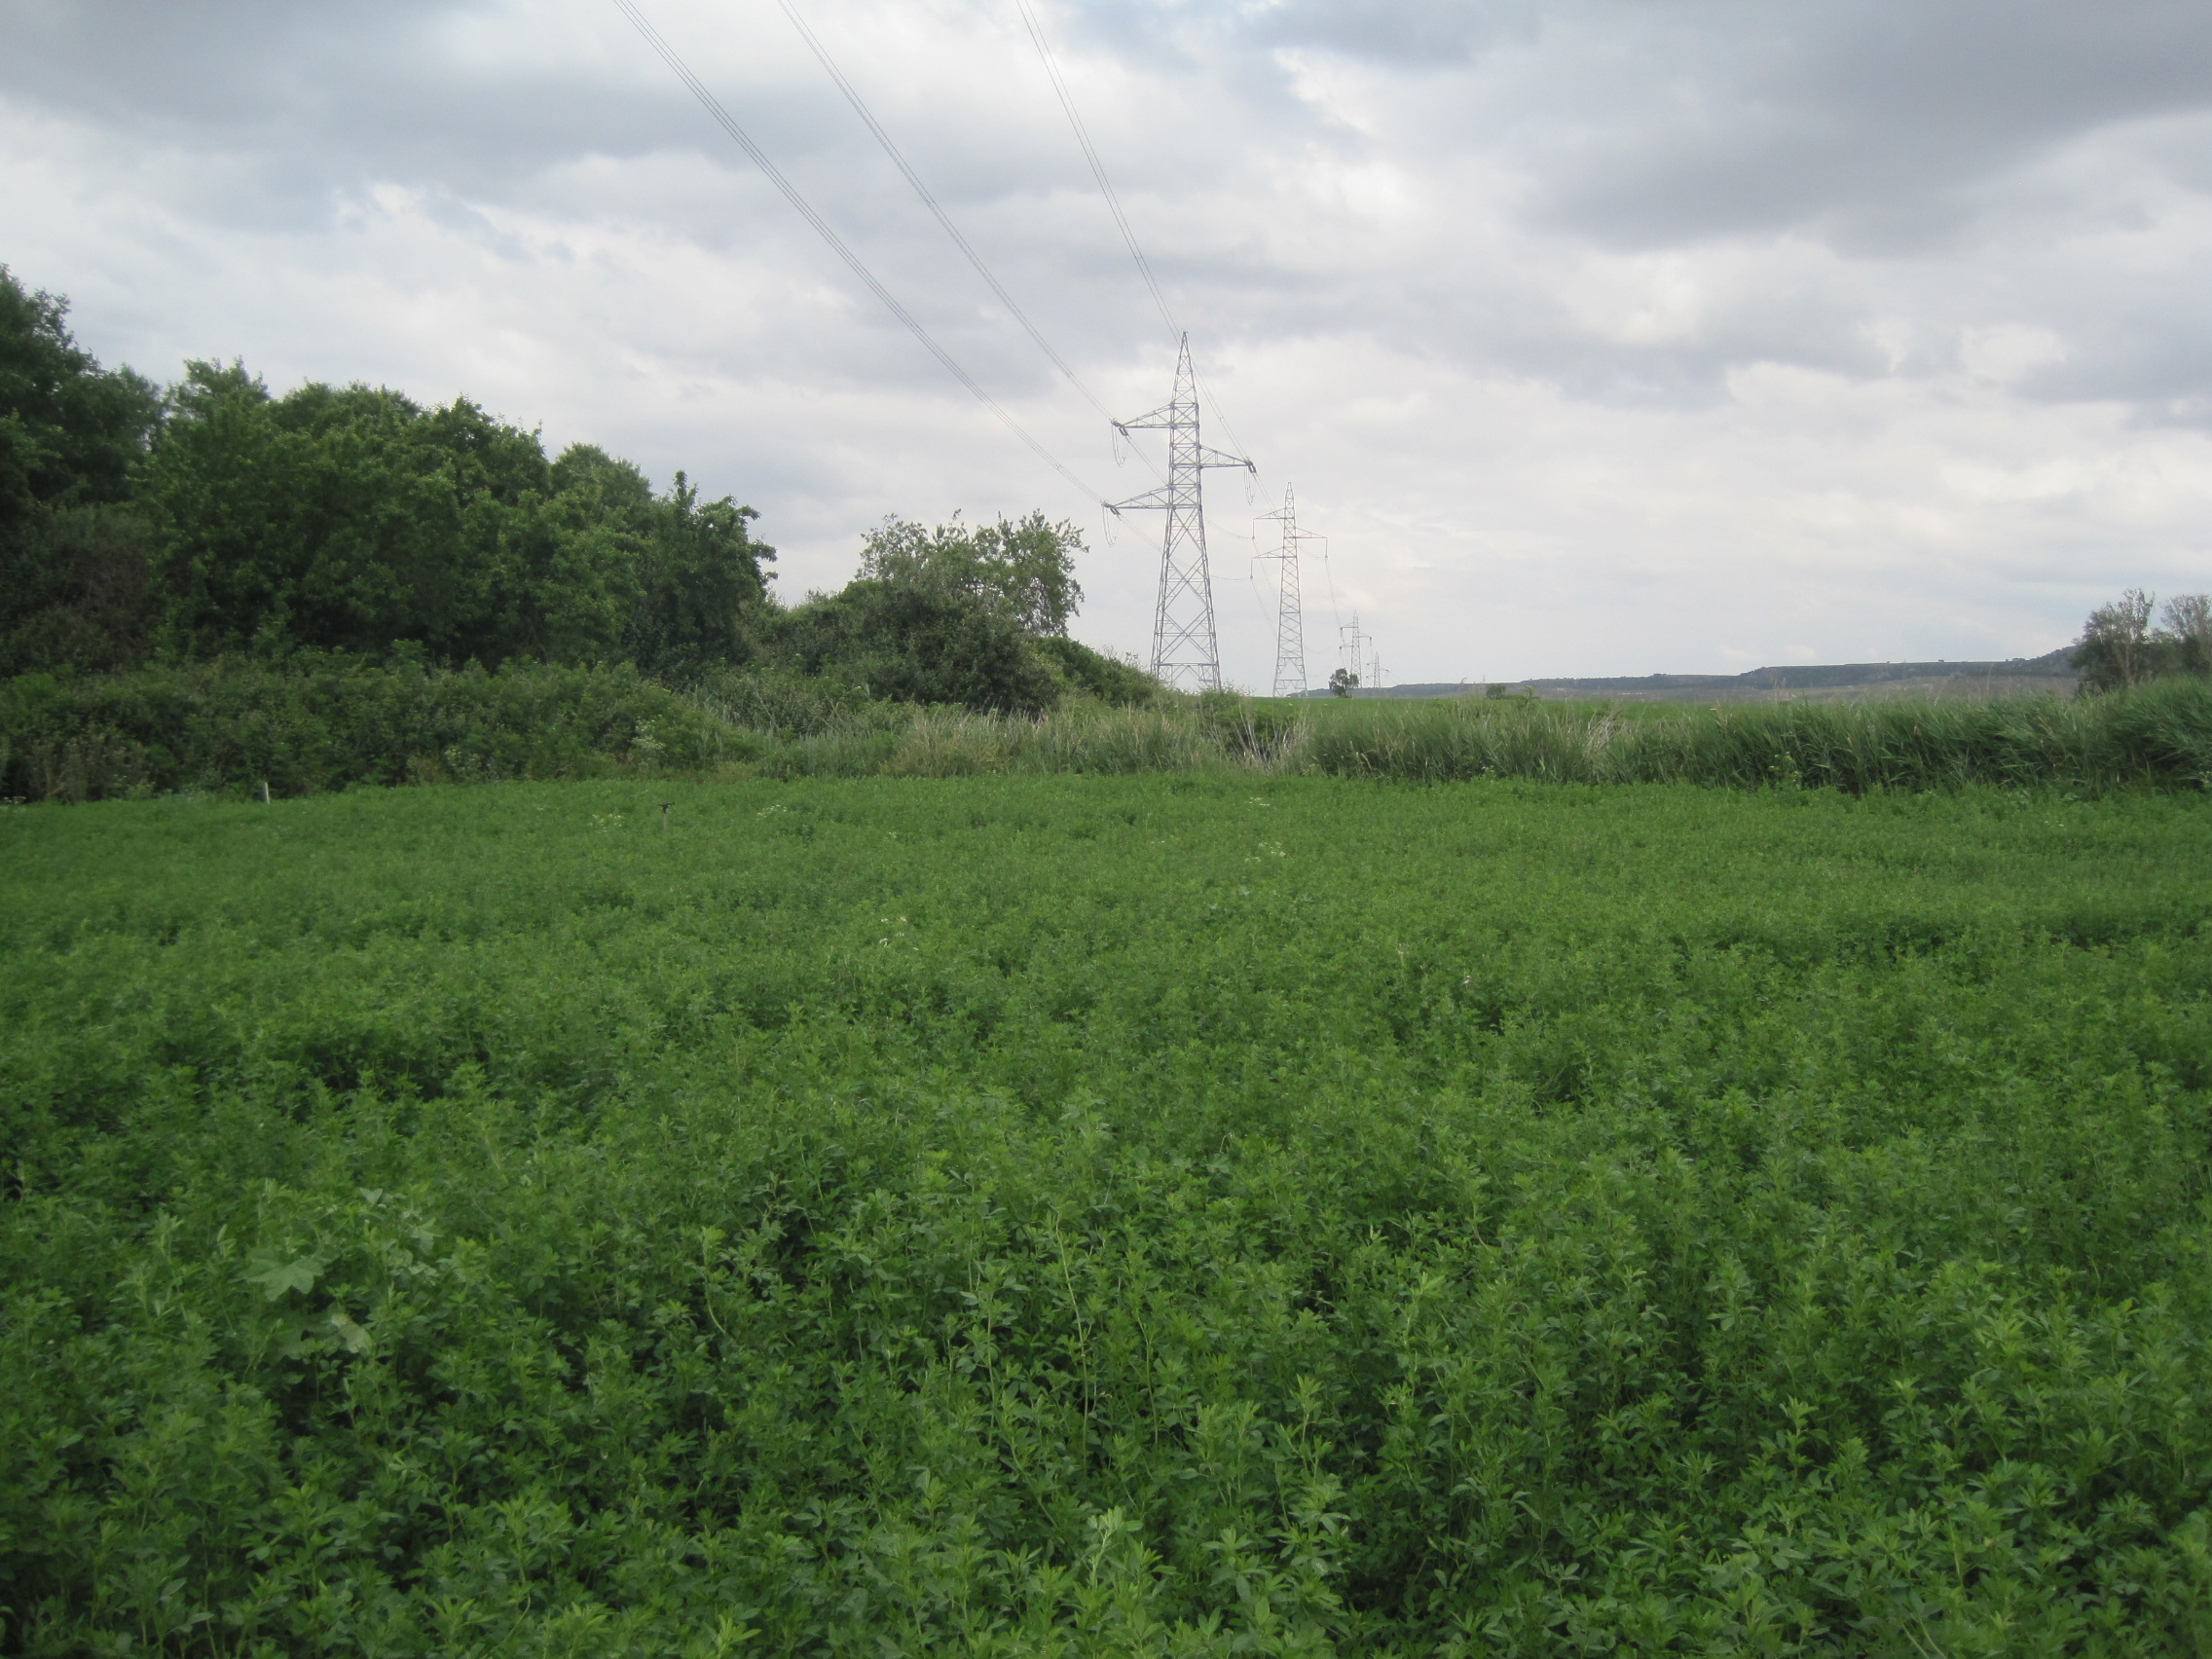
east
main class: Cropland
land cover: Lucerne
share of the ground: > 75 %
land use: Agriculture (excluding fallow land and kitchen gardens)
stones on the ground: 10 - 25 %
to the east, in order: Lucerne; Shruby margins; Ditches and canals; Abandoned hedges; Broadleaved woodland; Tracks; Broadleaved woodland; Fences; Lucerne; Electric lines; Lucerne
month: June
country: ES
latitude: 41.7251
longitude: -4.6749
